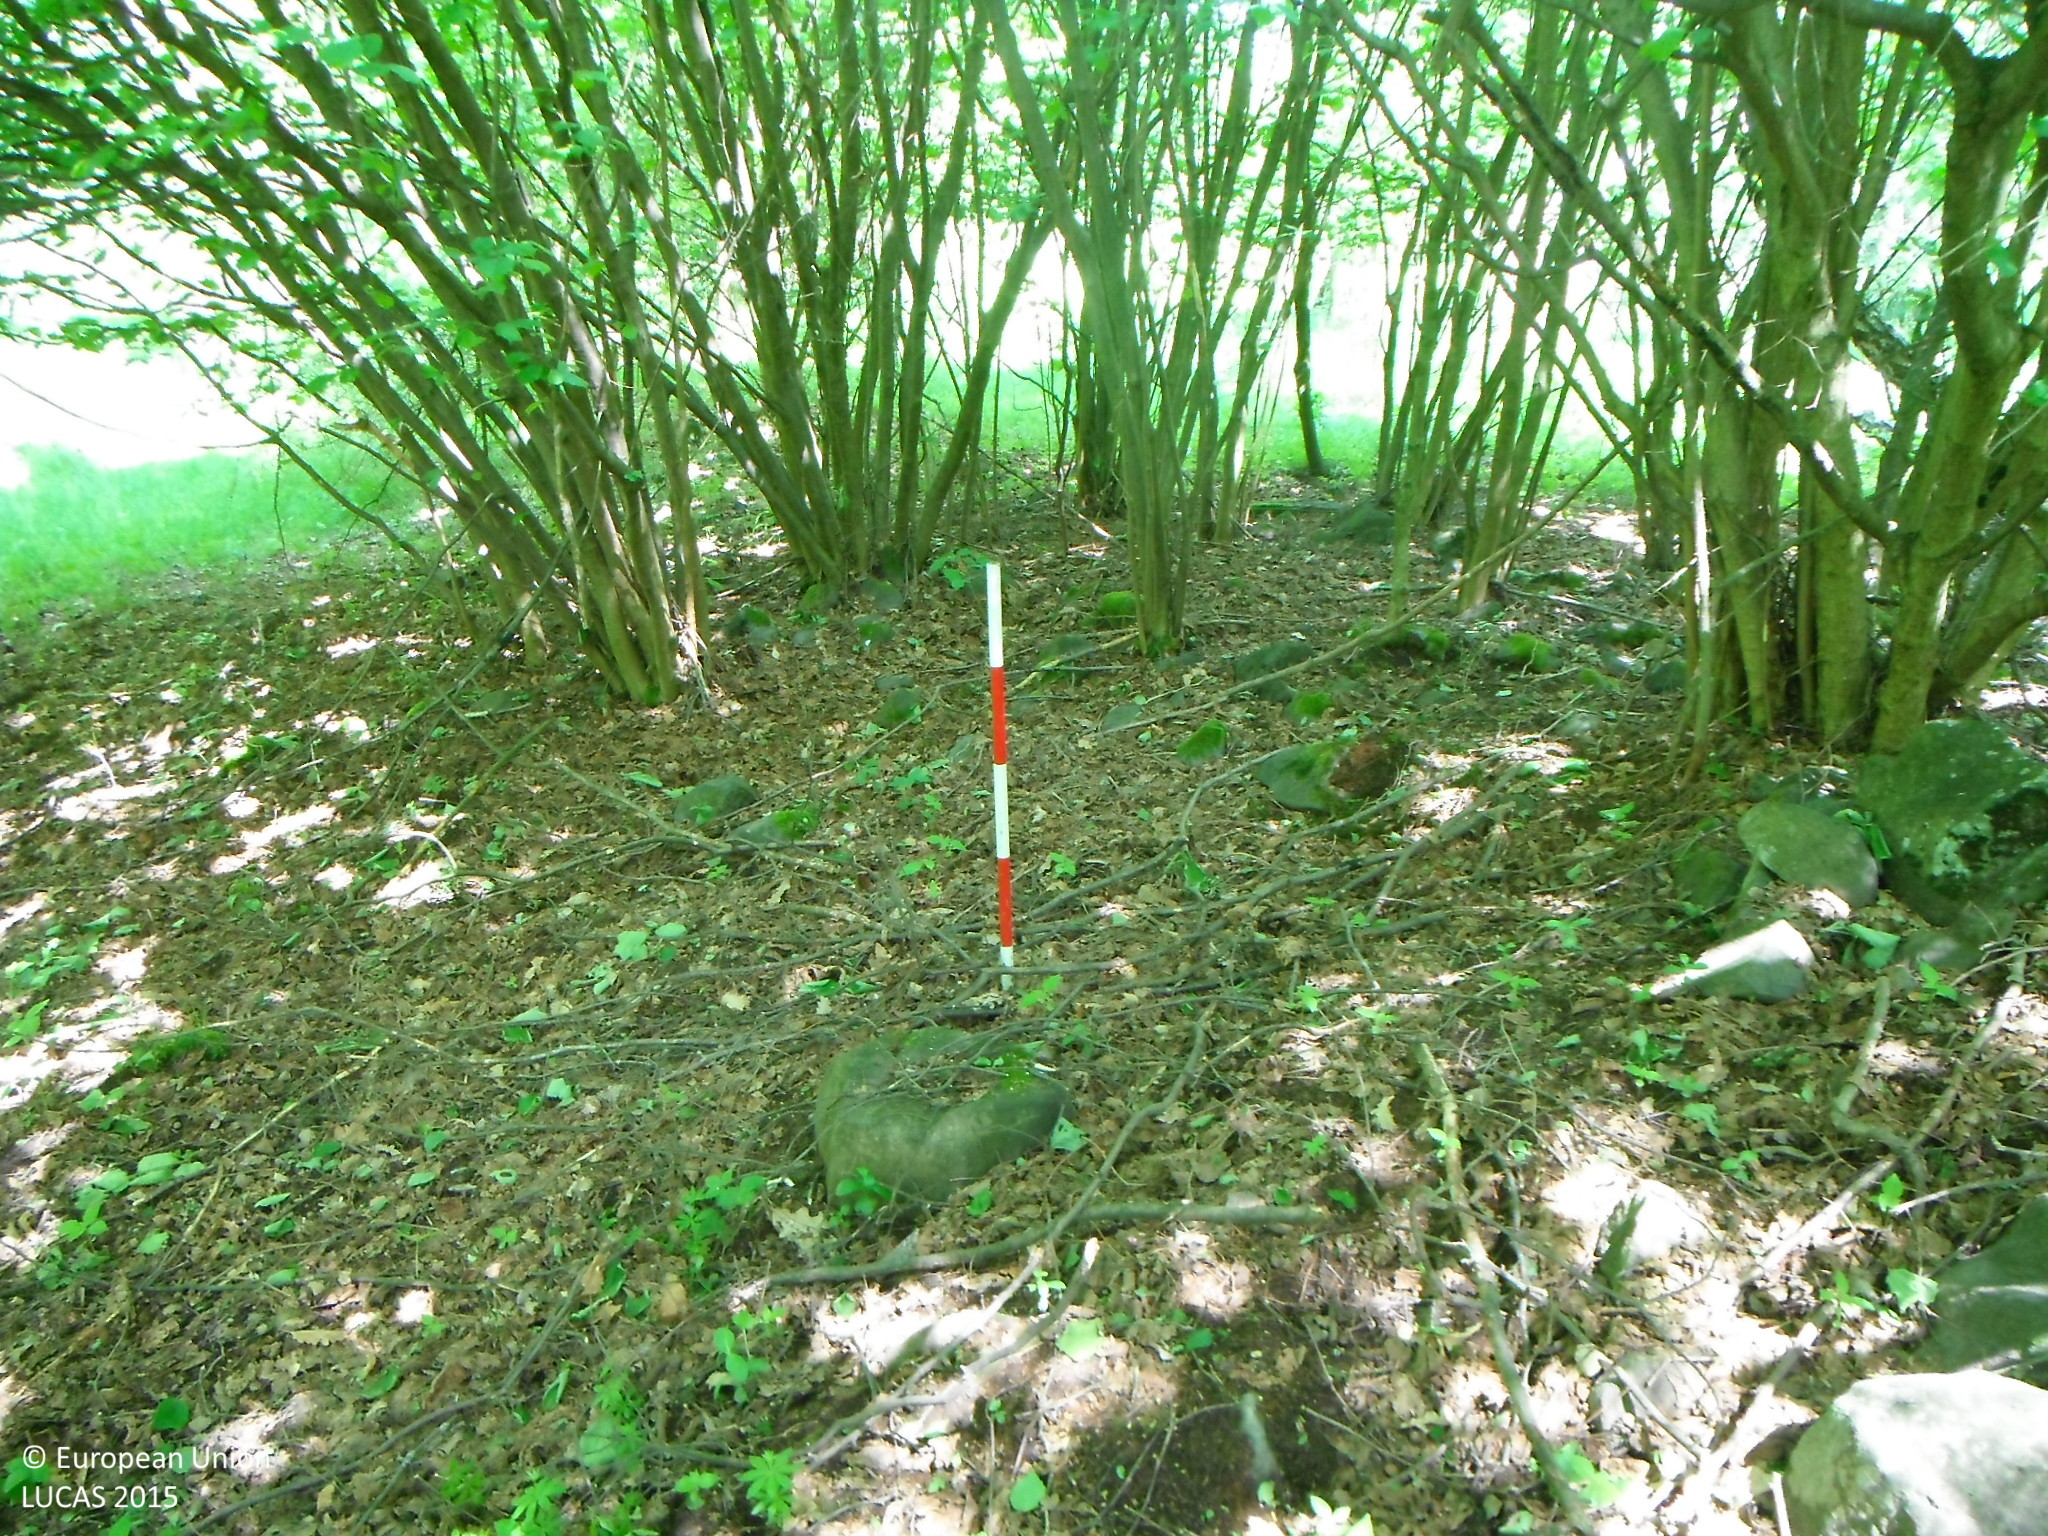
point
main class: Woodland
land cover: Broadleaved woodland
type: acidophilous oak and oak-birch forest
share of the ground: > 75 %
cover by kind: broadleaved forest trees 100 %
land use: Forestry
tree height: > 5 m
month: May
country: SK
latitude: 48.4334
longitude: 19.0086
